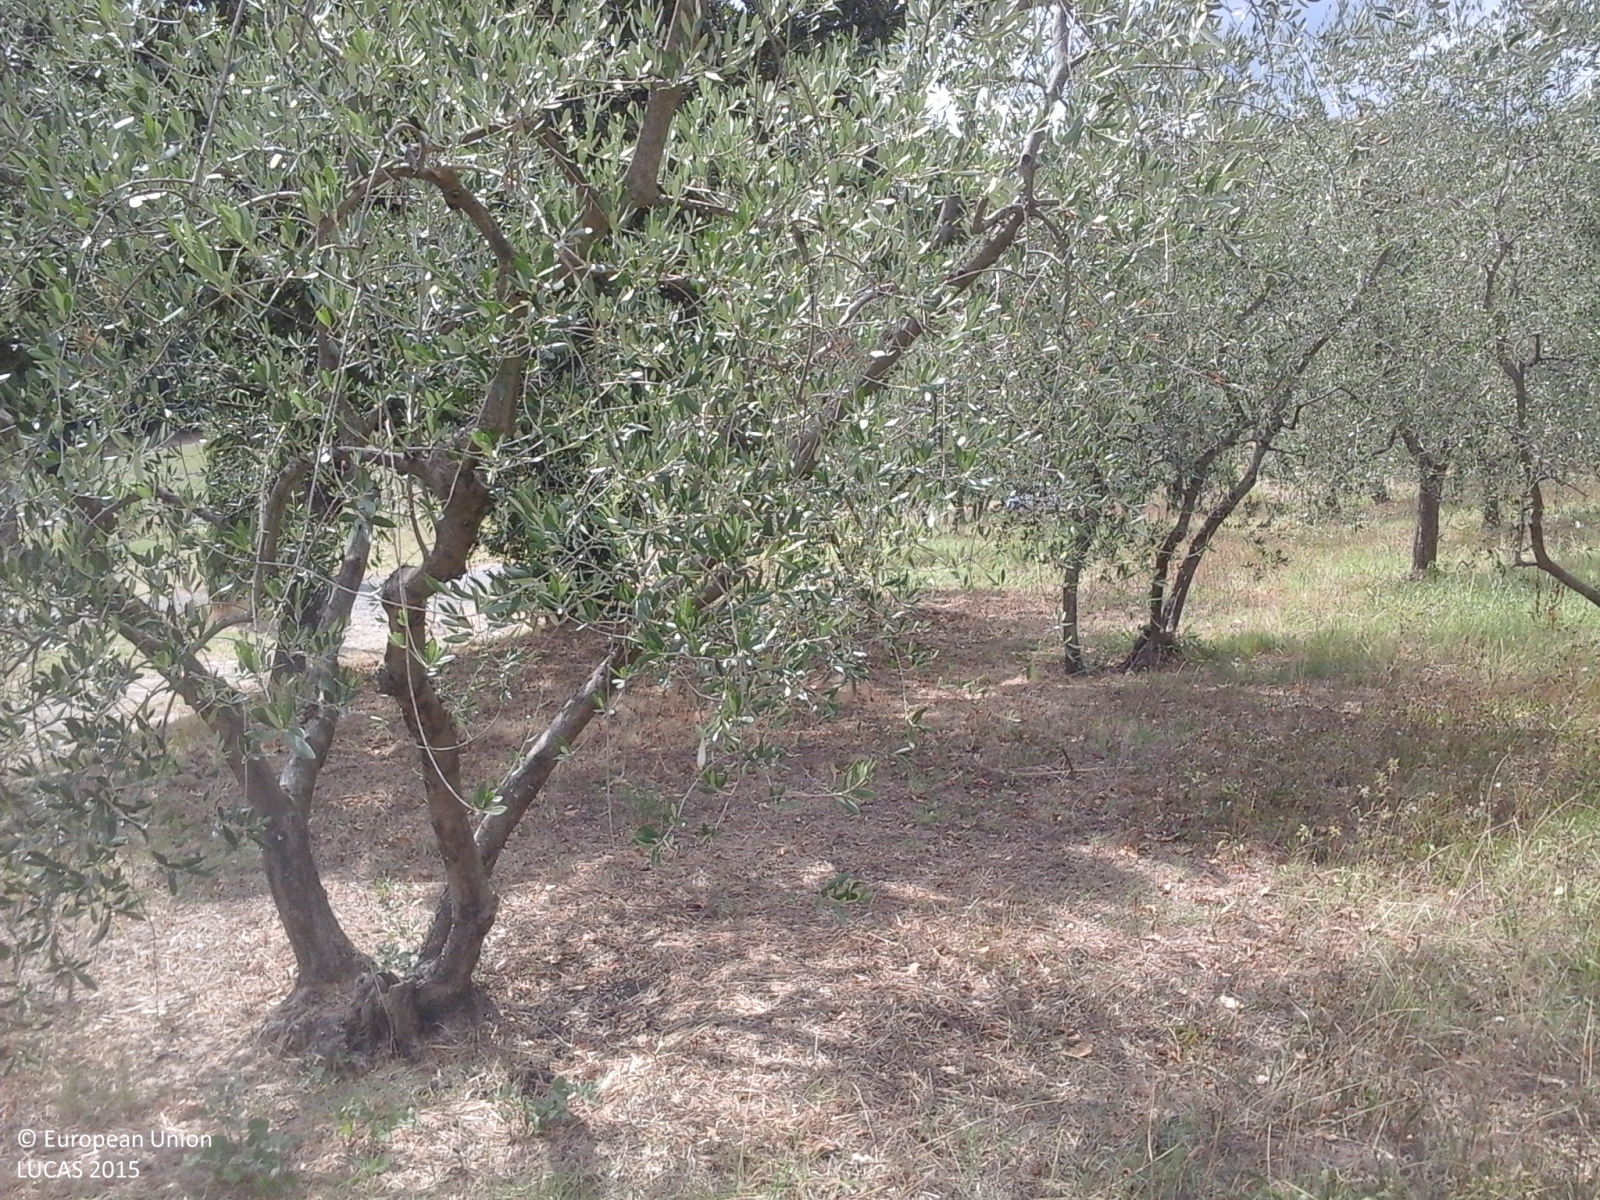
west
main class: Cropland
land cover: Olive groves
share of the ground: > 75 %
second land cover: Grassland without tree/shrub cover
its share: > 75 %
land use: Agriculture (excluding fallow land and kitchen gardens)
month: August
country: IT
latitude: 43.8778
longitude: 10.8813
